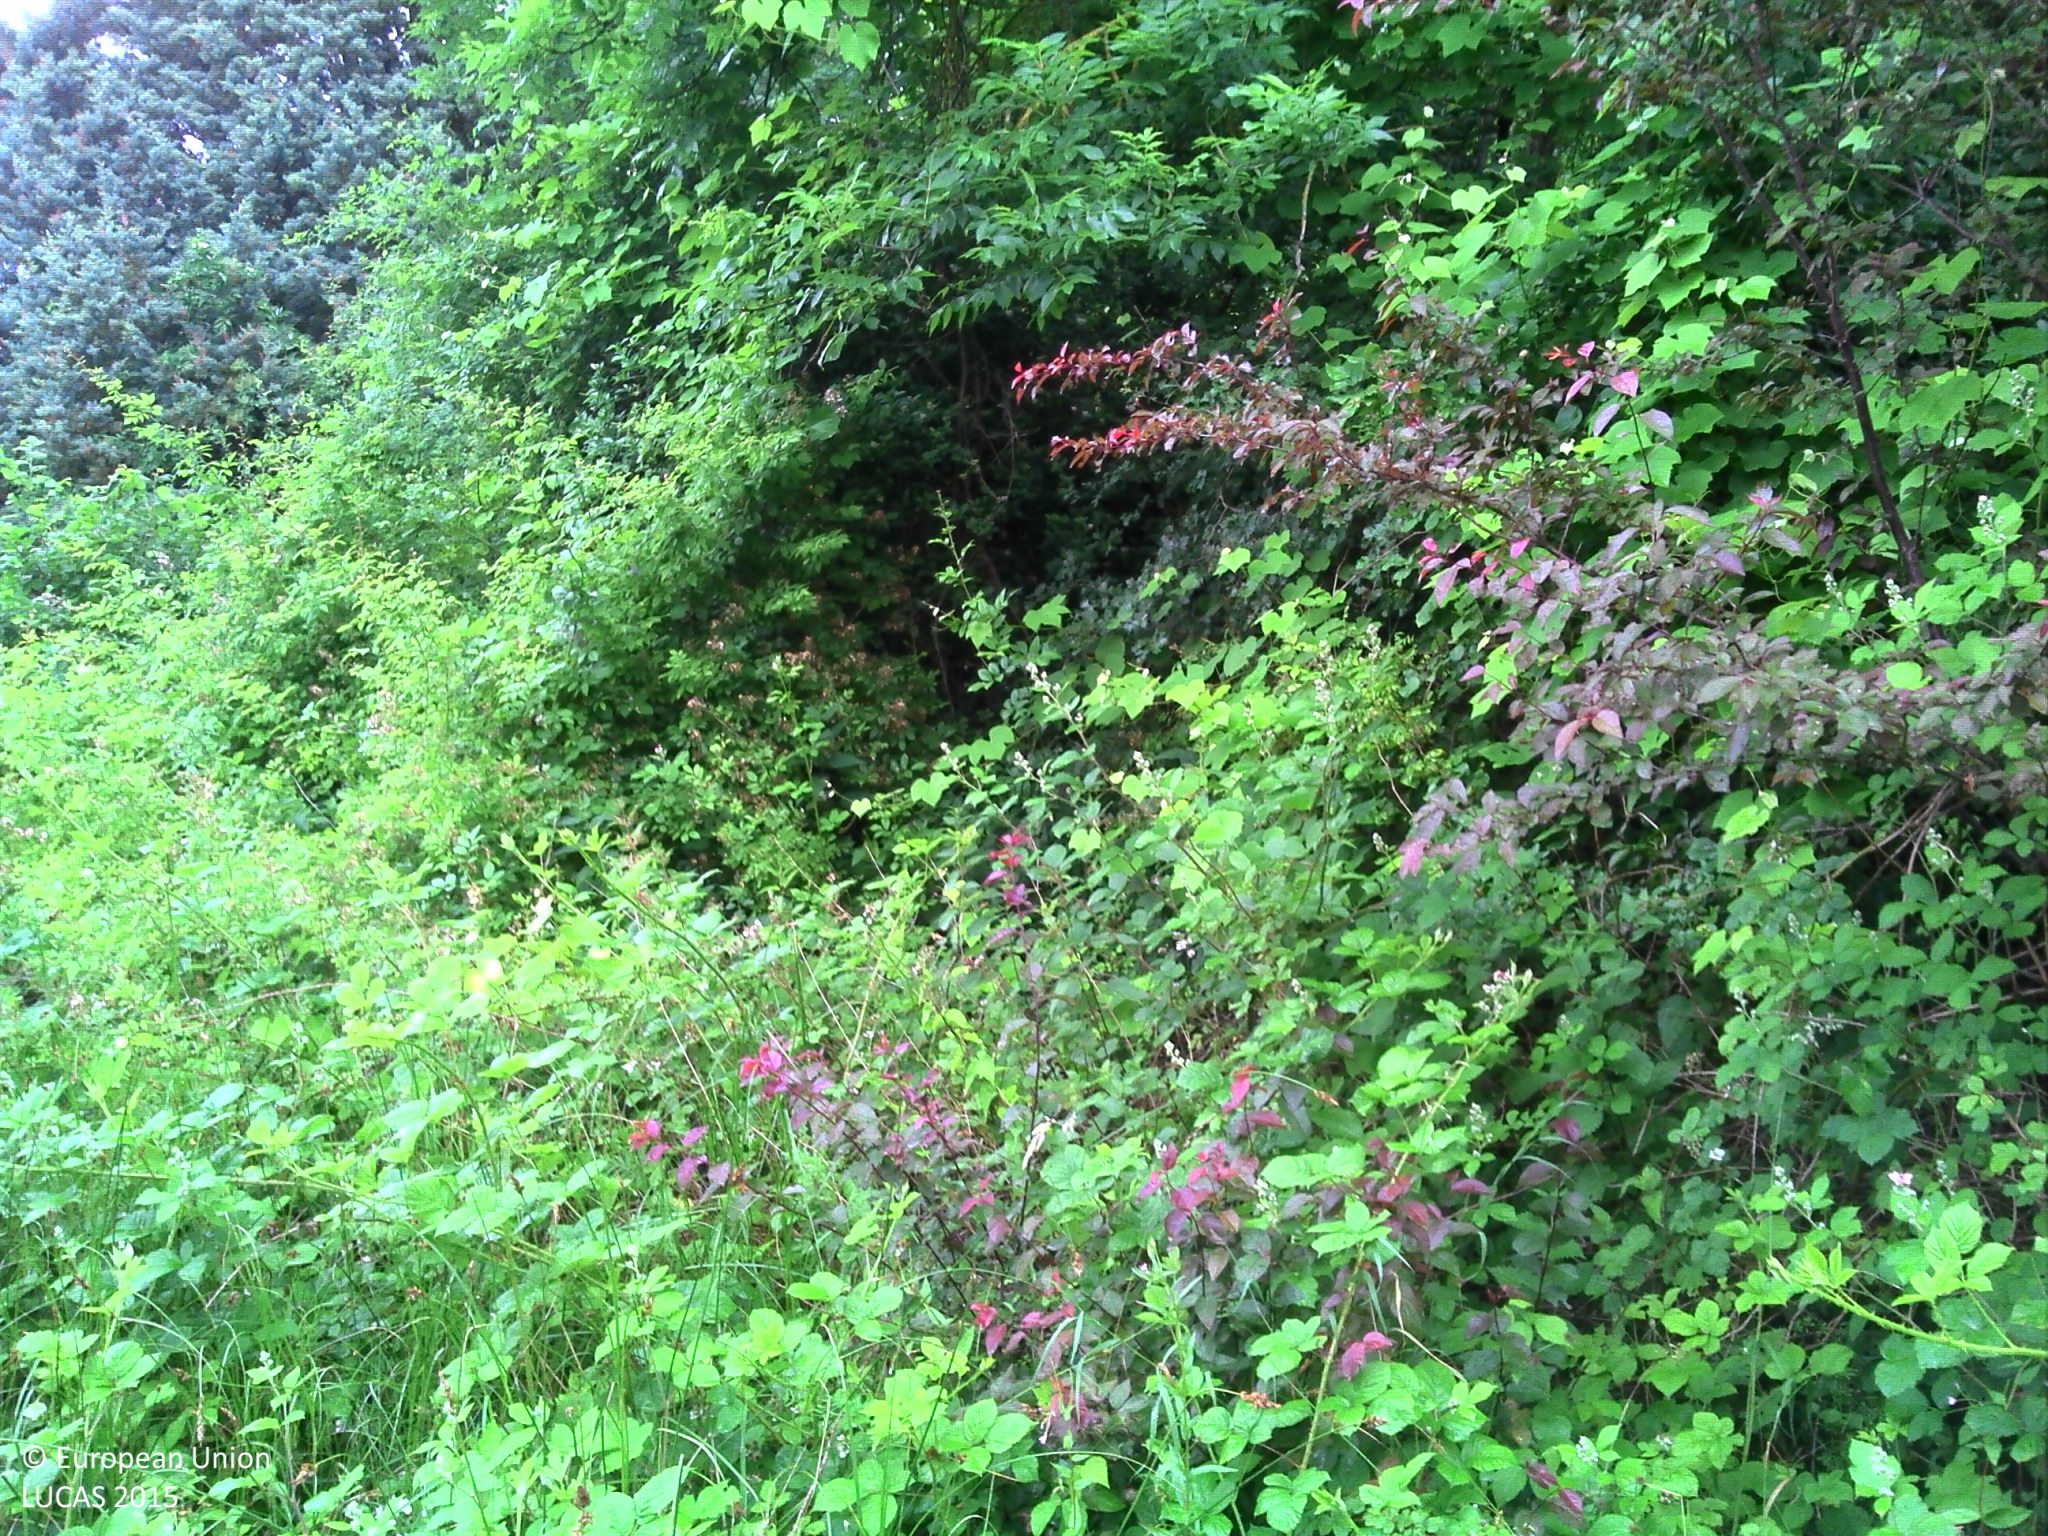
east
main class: Shrubland
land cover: Shrubland without tree cover
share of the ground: > 75 %
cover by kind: shrubs 90 %, herbaceous plants 10 %
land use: Semi-natural and natural areas not in use
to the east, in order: Shrubland without tree cover; Other mixed woodland; Shrubland with sparse tree cover; Grassland without tree/shrub cover; Electric lines; Grassland without tree/shrub cover; Barley; Electric lines; Barley; Grass margins; Tracks; Grass margins; Electric lines; Barley
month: June
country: FR
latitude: 48.6458
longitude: 6.2405
